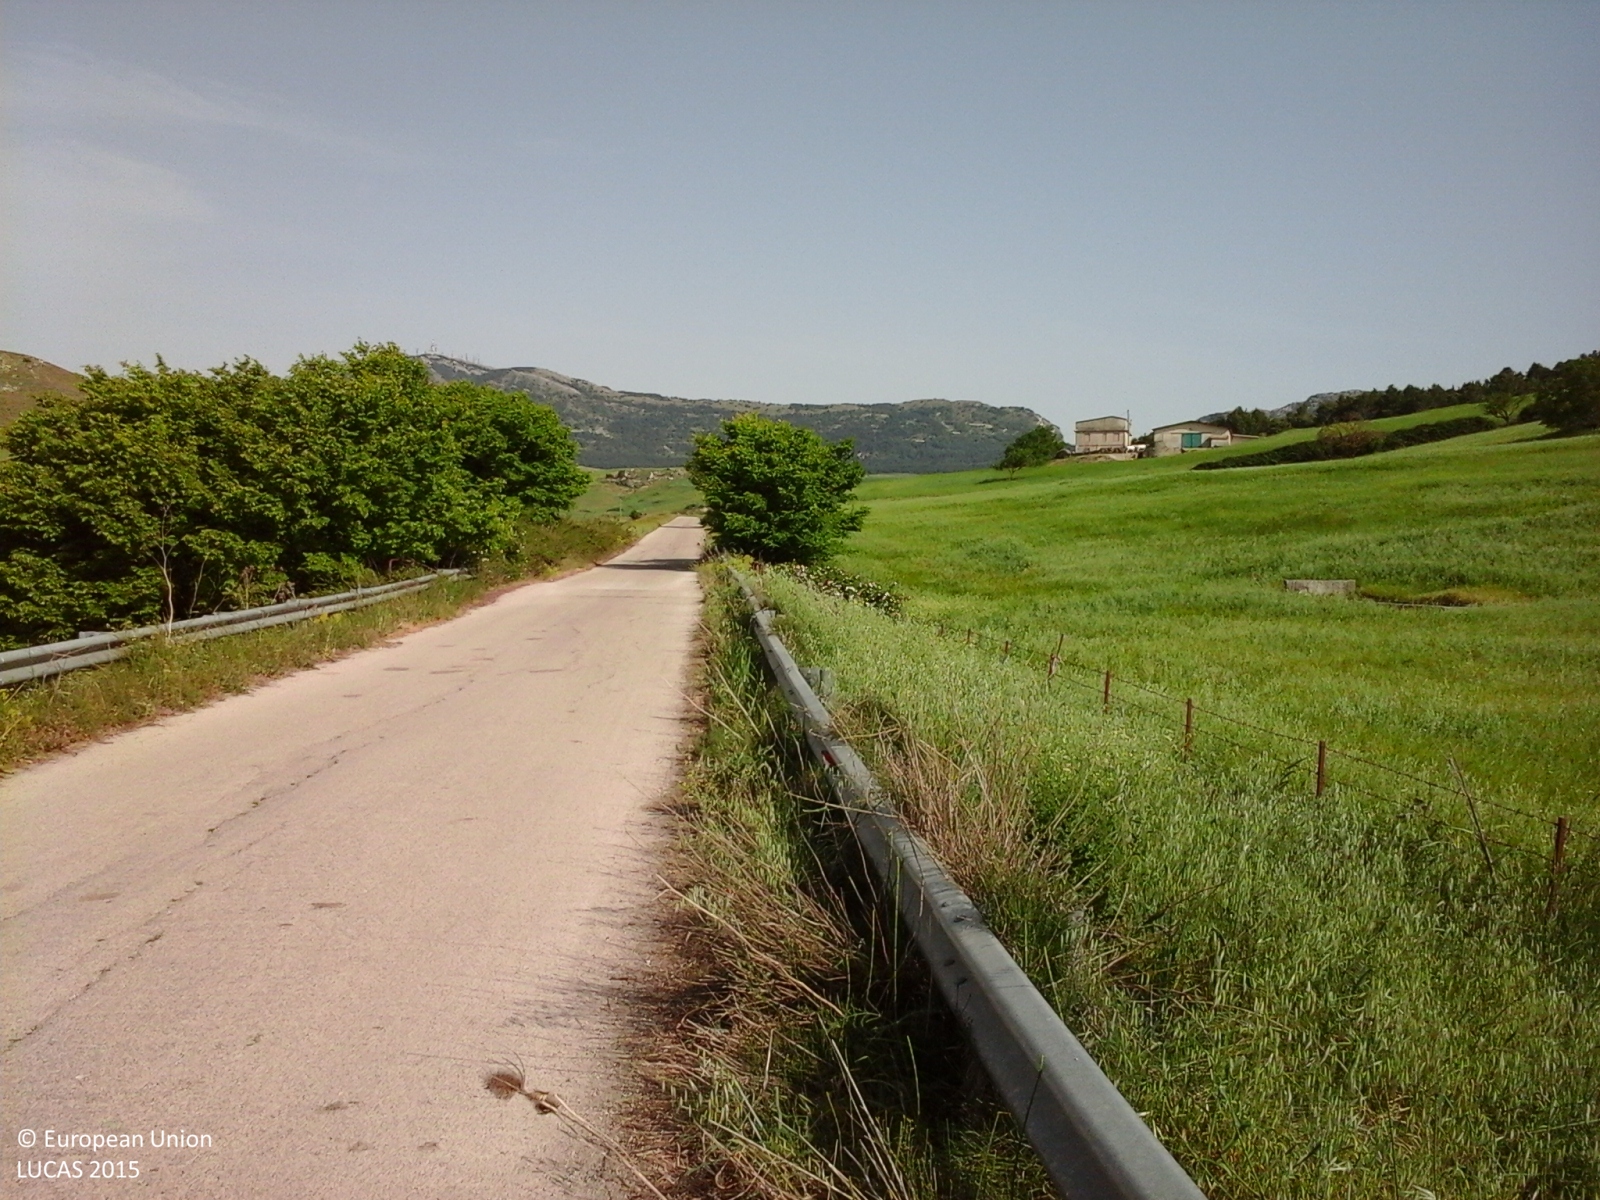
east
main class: Cropland
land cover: Mixed cereals for fodder
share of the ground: > 75 %
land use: Agriculture (excluding fallow land and kitchen gardens)
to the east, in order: Mixed cereals for fodder; Shrubland with sparse tree cover; Mixed cereals for fodder; Grass margins; Fences; Olive groves; Fences; Temporary grasslands
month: May
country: IT
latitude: 37.6452
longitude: 13.5437
